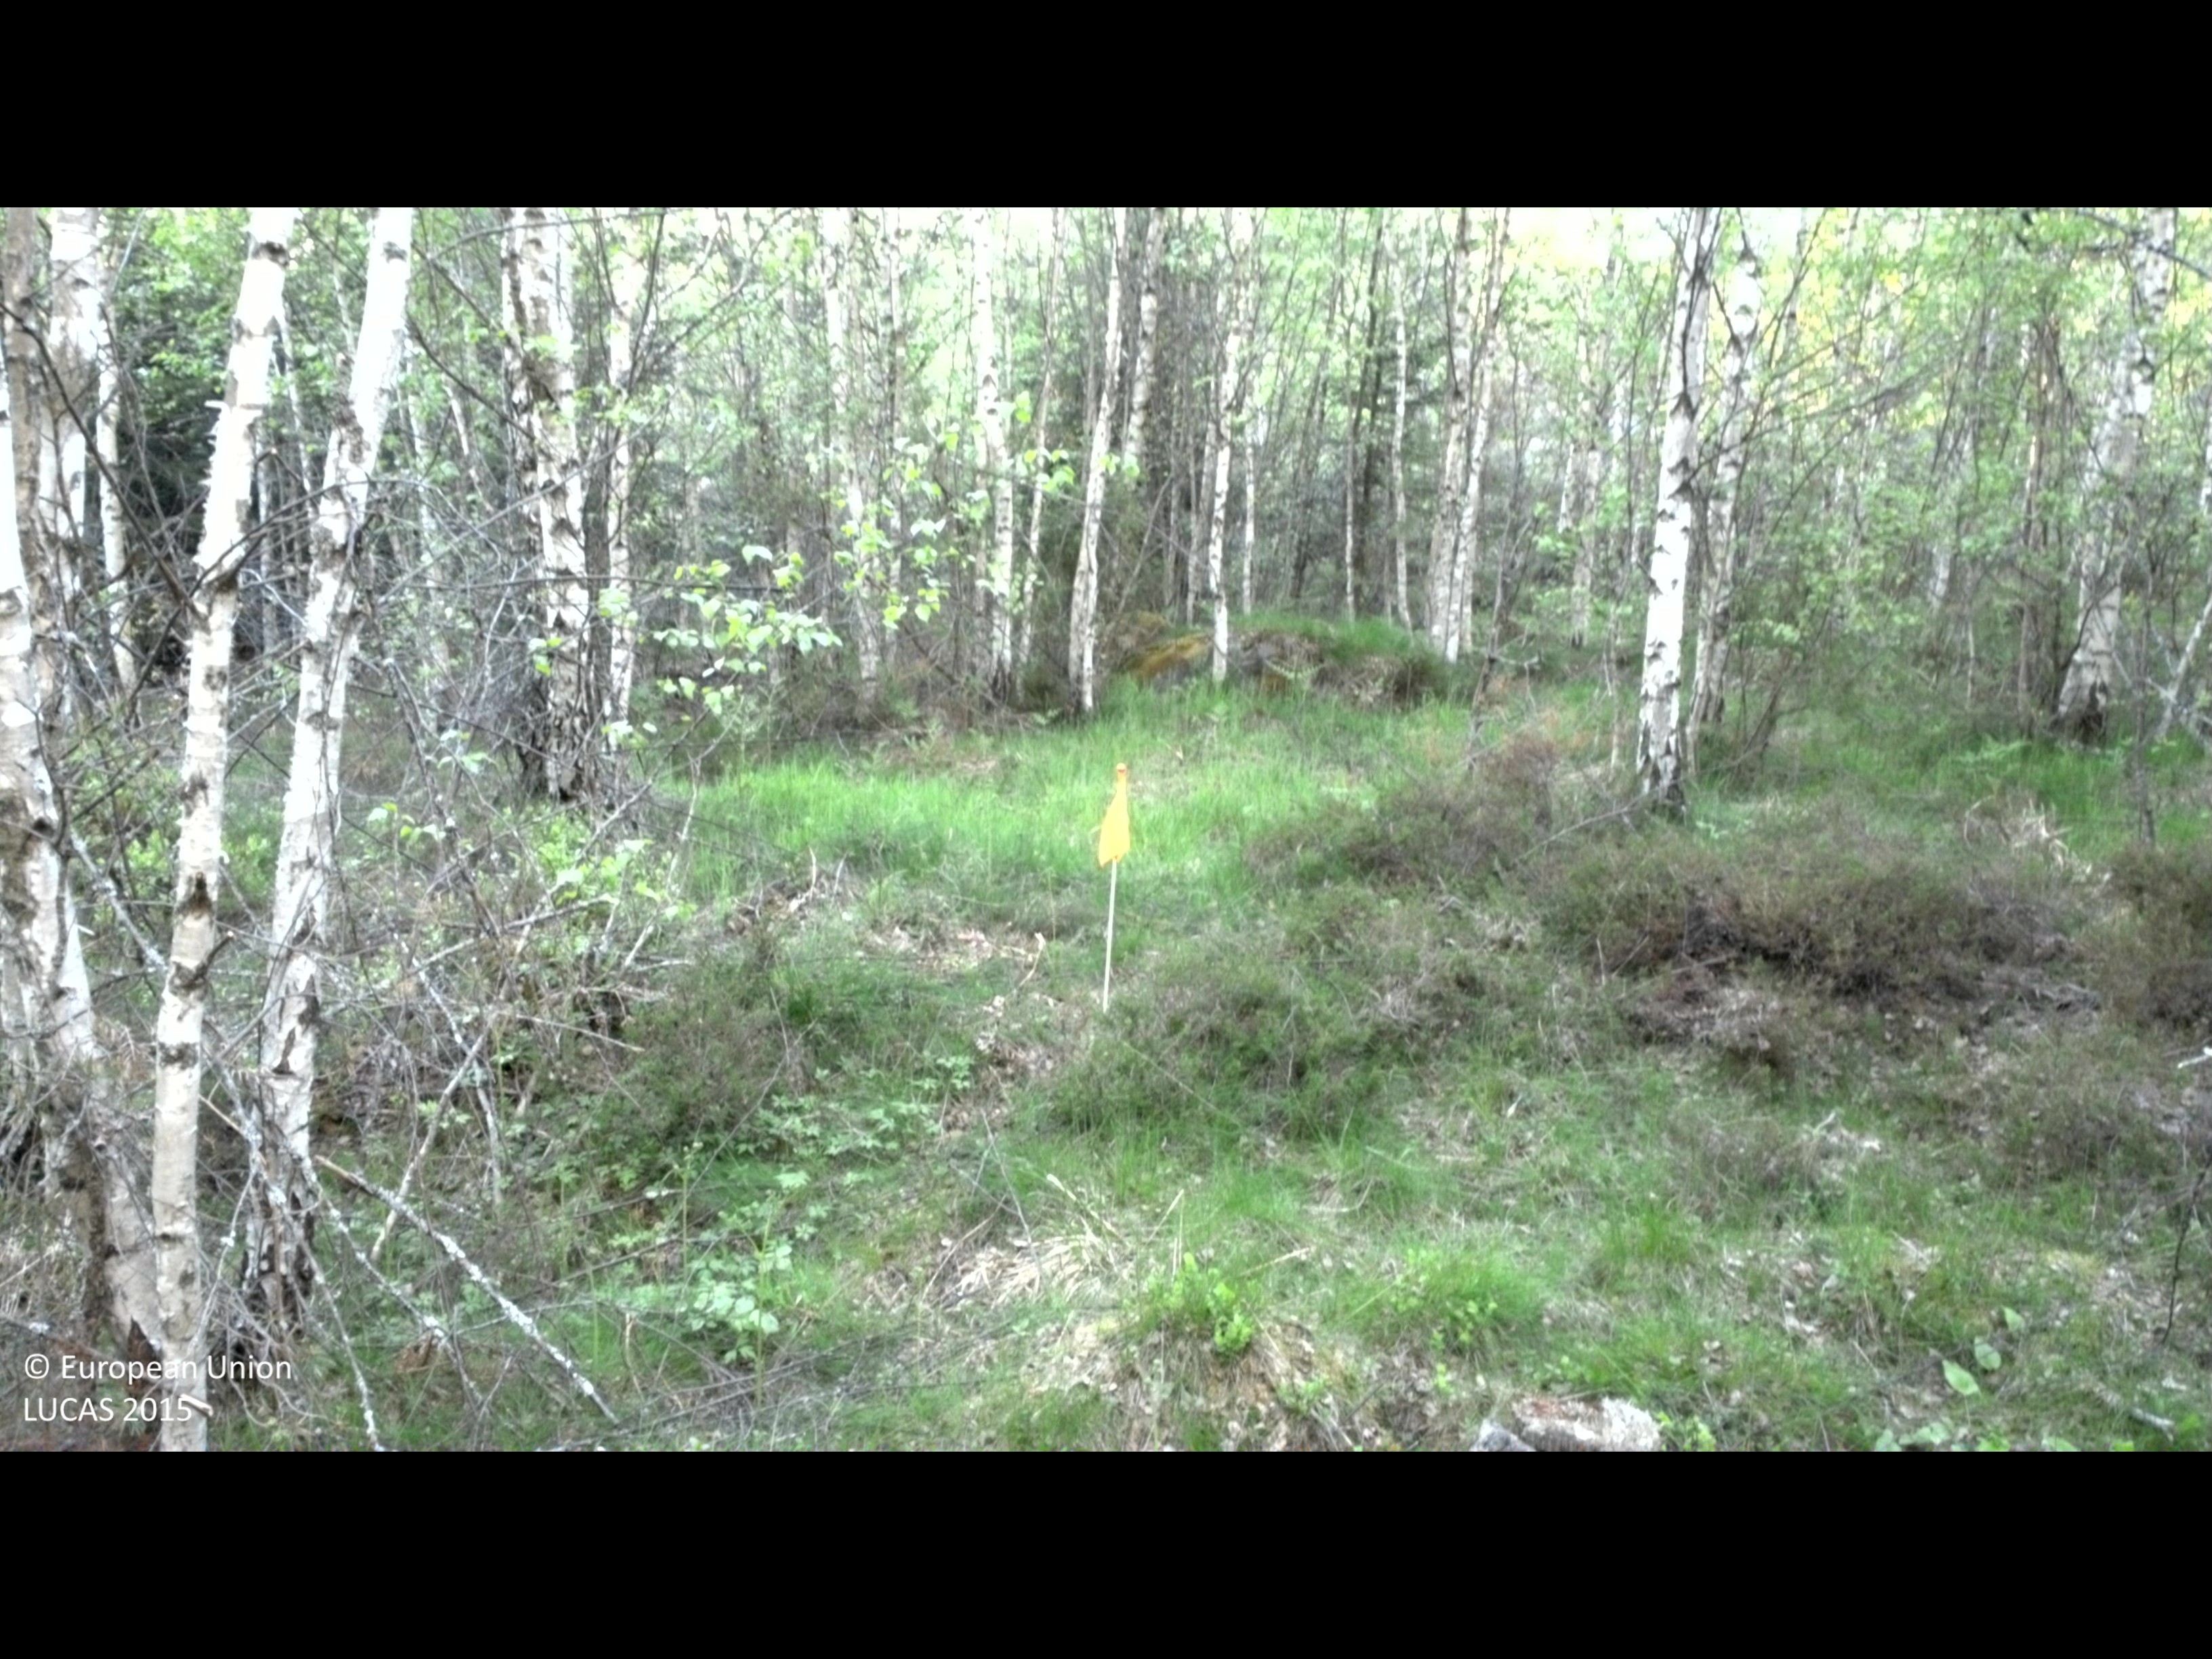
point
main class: Woodland
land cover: Broadleaved woodland
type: hemiboreal forest and nemoral coniferous forest and mixed broadleaved-coniferous forest
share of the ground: 50 - 75 %
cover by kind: broadleaved forest trees 70 %, herbaceous plants 15 %, shrubs 10 %, coniferous forest trees 5 %
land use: Forestry
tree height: > 5 m
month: May
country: SE
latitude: 57.3190
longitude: 16.1925
